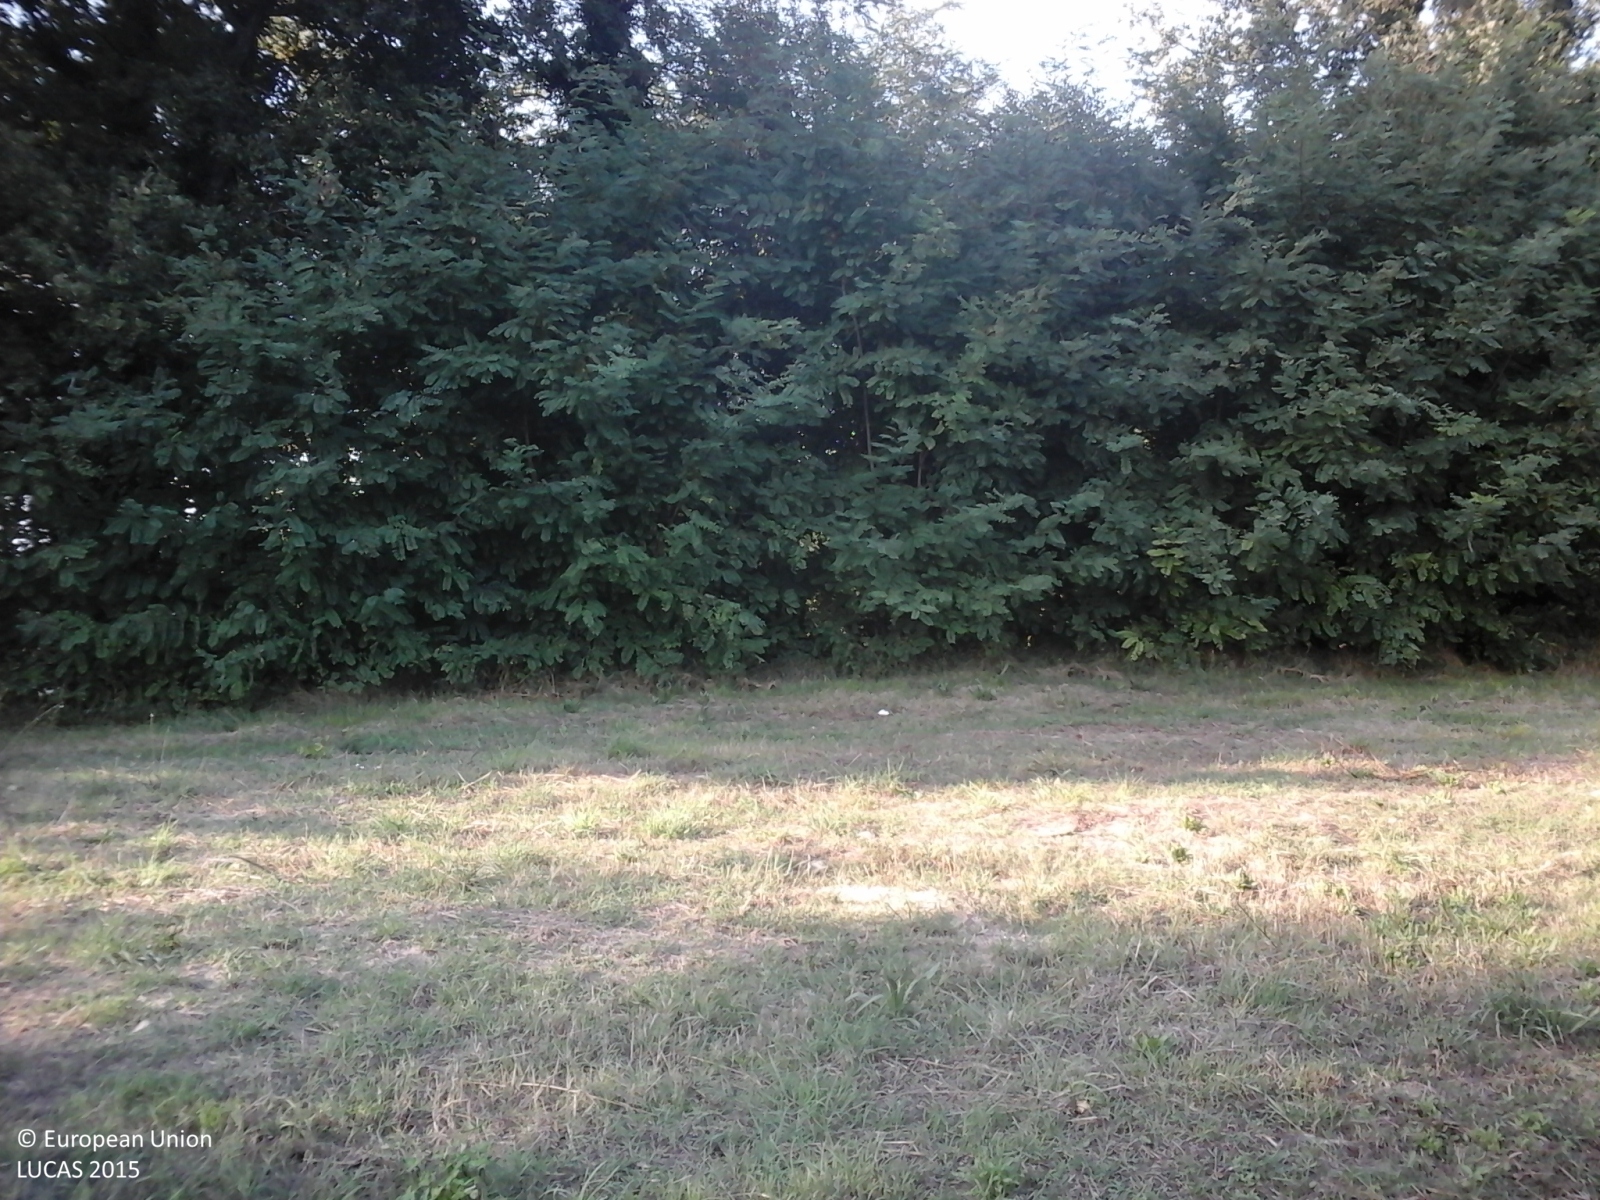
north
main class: Woodland
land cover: Broadleaved woodland
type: thermophilous deciduous forest
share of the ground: > 75 %
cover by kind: broadleaved forest trees 100 %
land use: Semi-natural and natural areas not in use
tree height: > 5 m
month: August
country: IT
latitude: 42.9941
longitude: 13.4126
